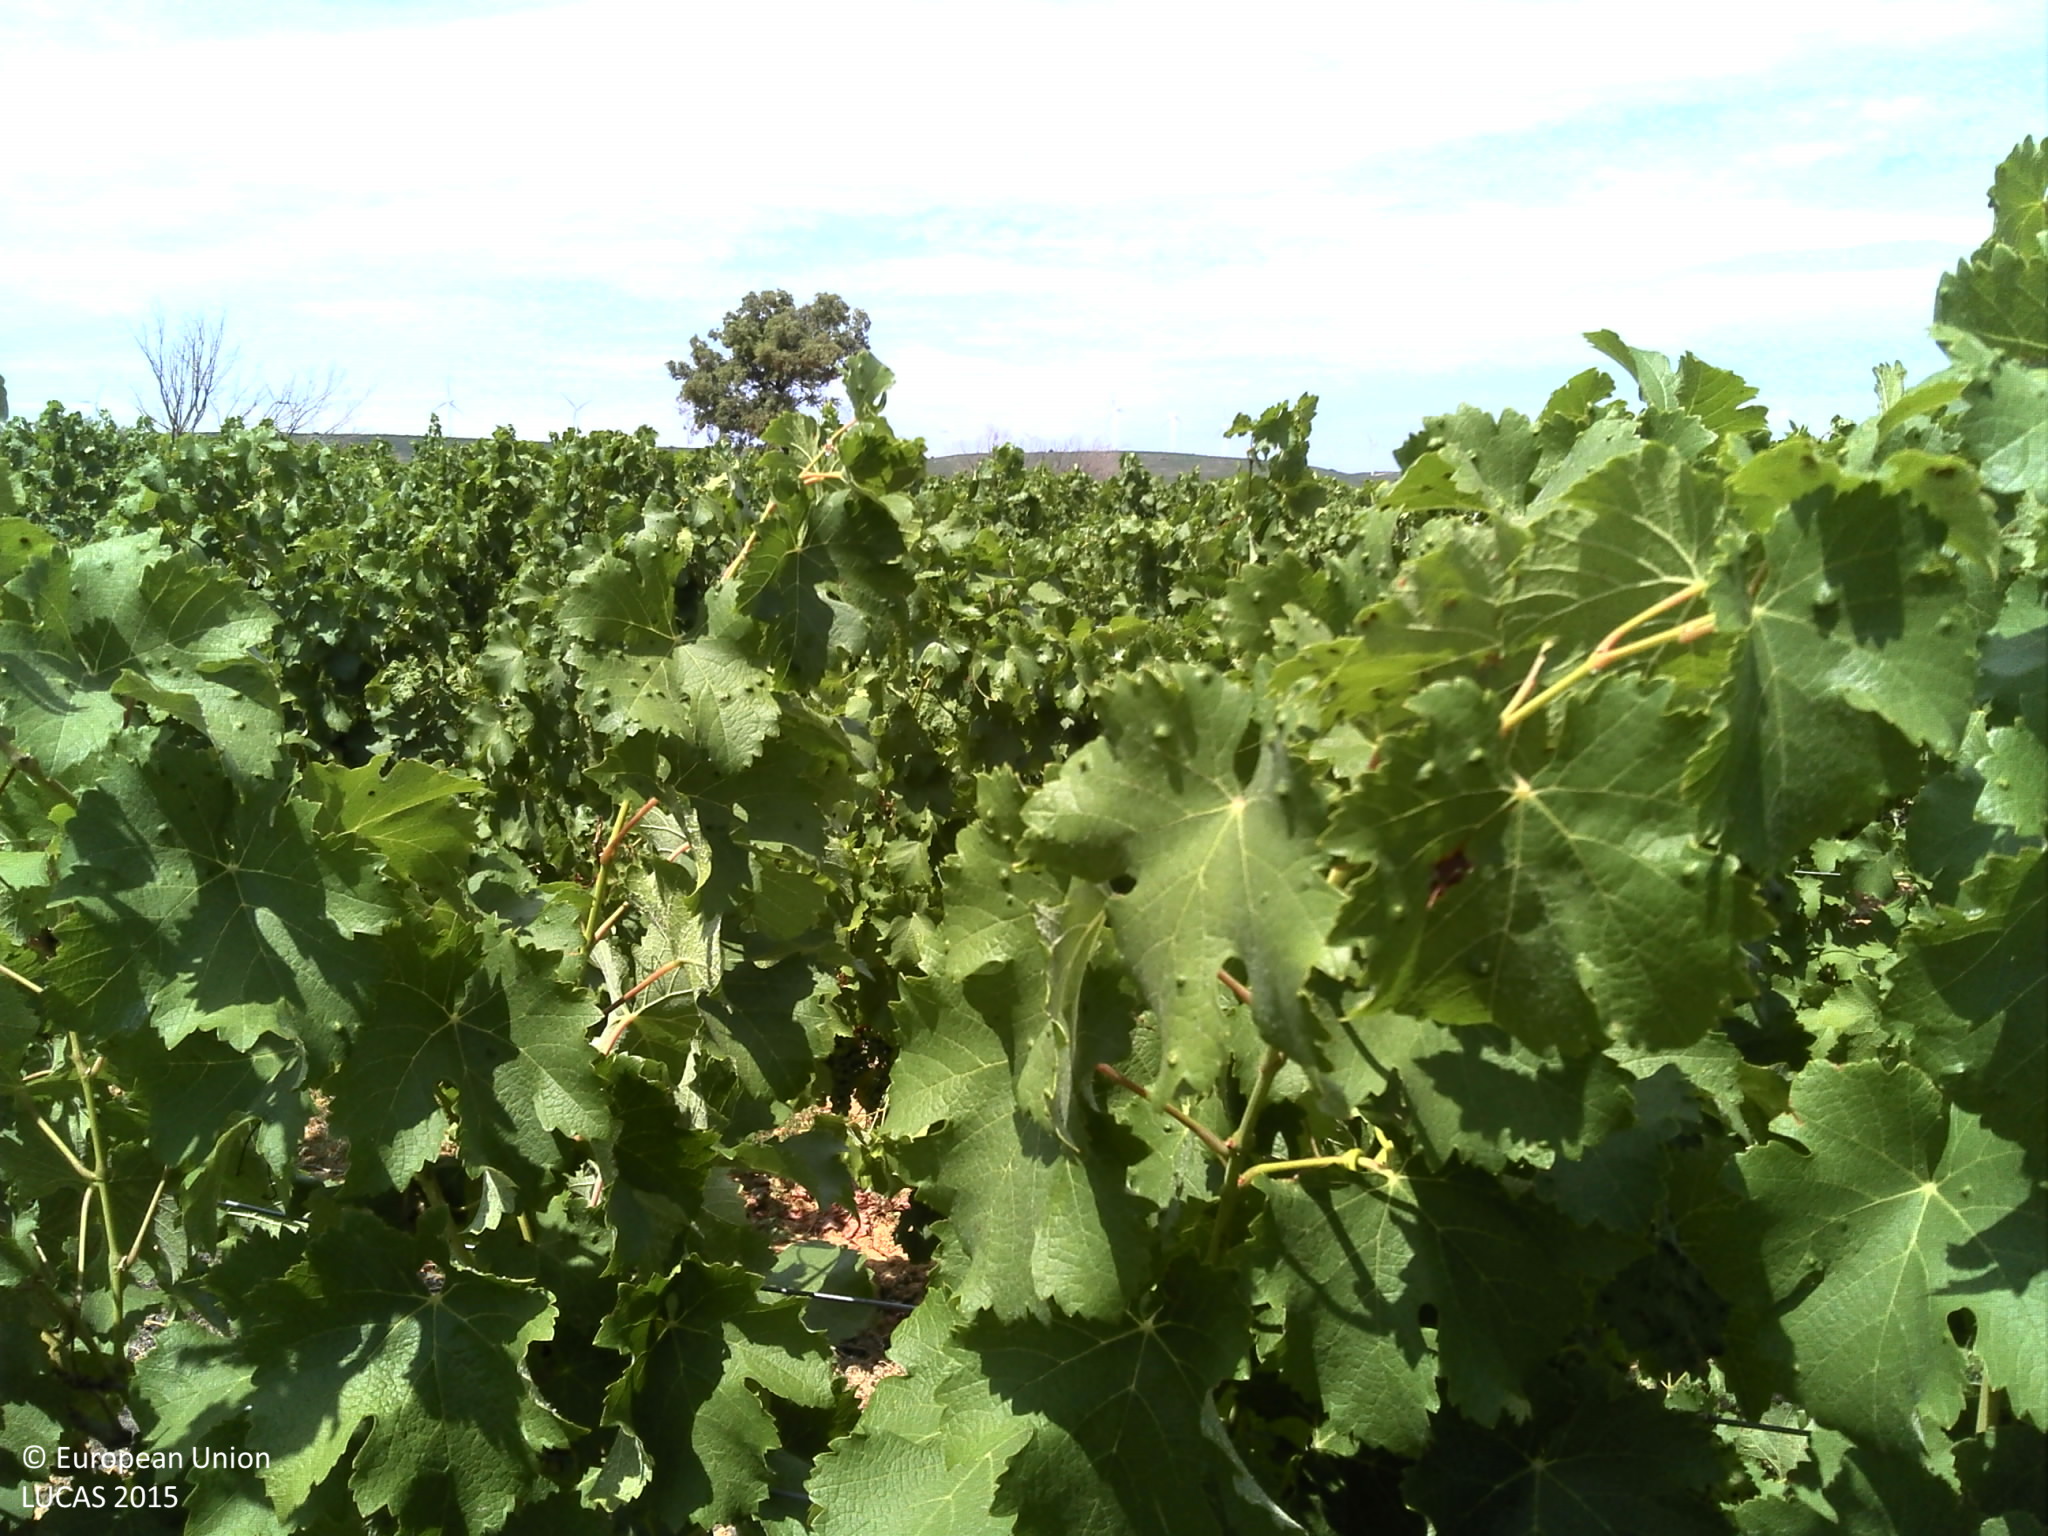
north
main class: Cropland
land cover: Vineyards
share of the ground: 25 - 50 %
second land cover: Other bare soil
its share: > 75 %
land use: Agriculture (excluding fallow land and kitchen gardens)
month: July
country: FR
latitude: 43.5025
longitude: 3.6151
